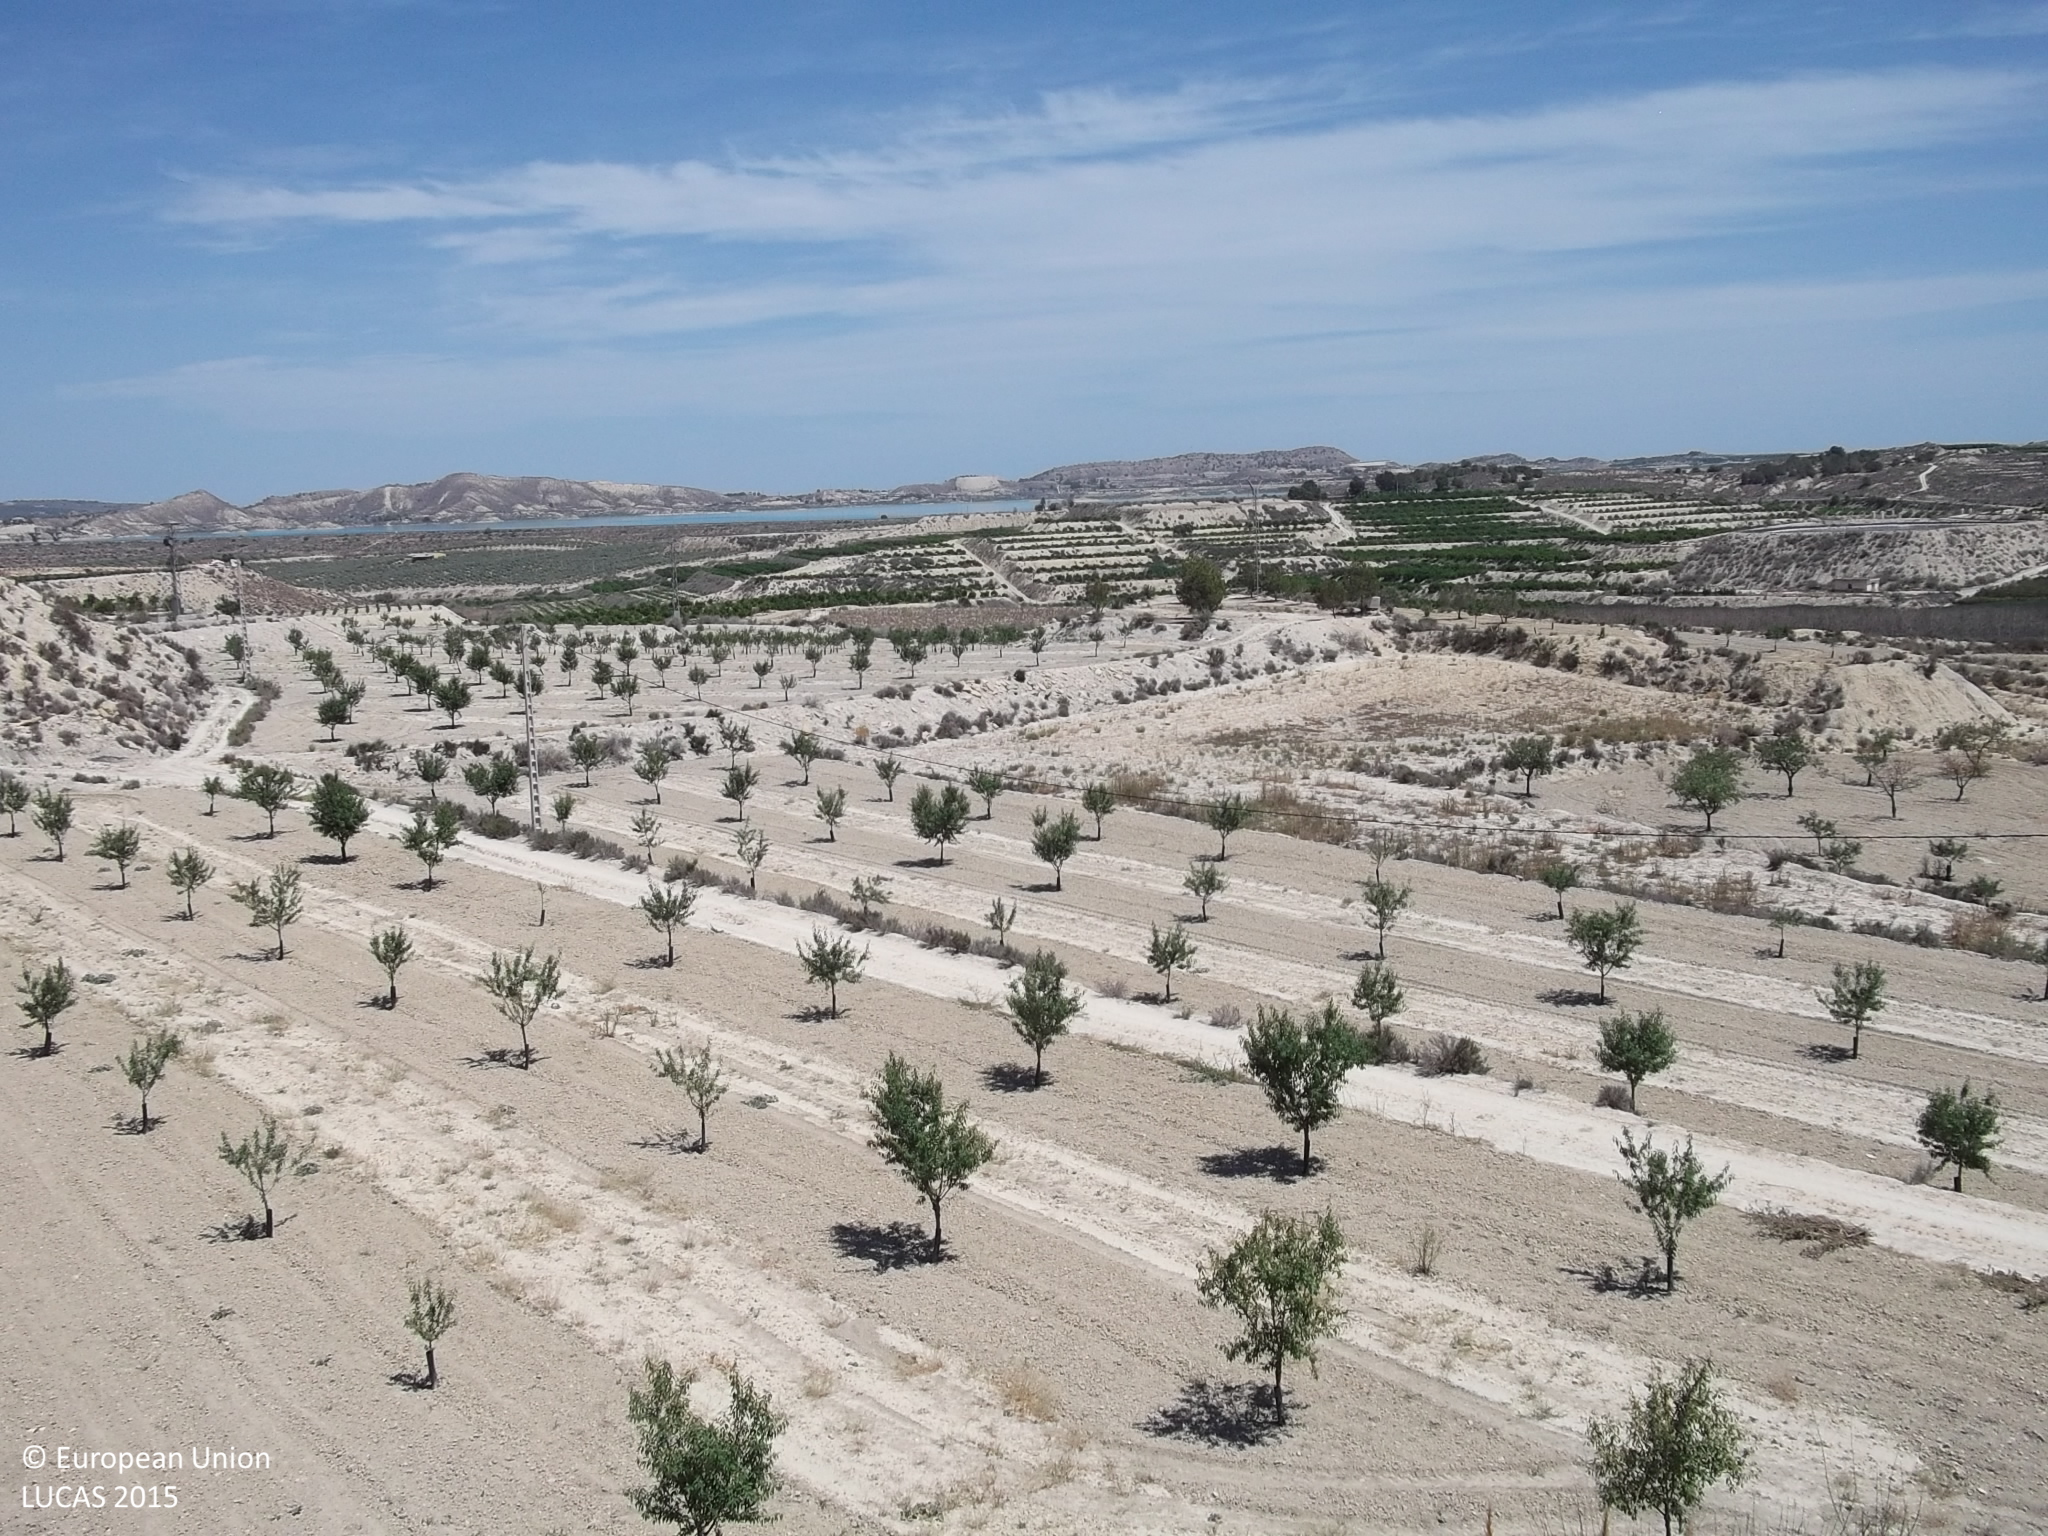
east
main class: Shrubland
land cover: Shrubland without tree cover
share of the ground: 25 - 50 %
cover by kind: shrubs 40 %, consolidated bare surface 40 %, herbaceous plants 20 %
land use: Semi-natural and natural areas not in use
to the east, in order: Shrubland without tree cover; Tracks; Nuts trees; Tracks; Grass margins; Electric lines; Nuts trees; Grass margins; Spontaneously vegetated surfaces; Grass margins; Pine dominated coniferous woodland; Grass margins; Electric lines; Olive groves; Shrubland without tree cover; Nuts trees
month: May
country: ES
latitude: 38.0141
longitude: -0.9064
